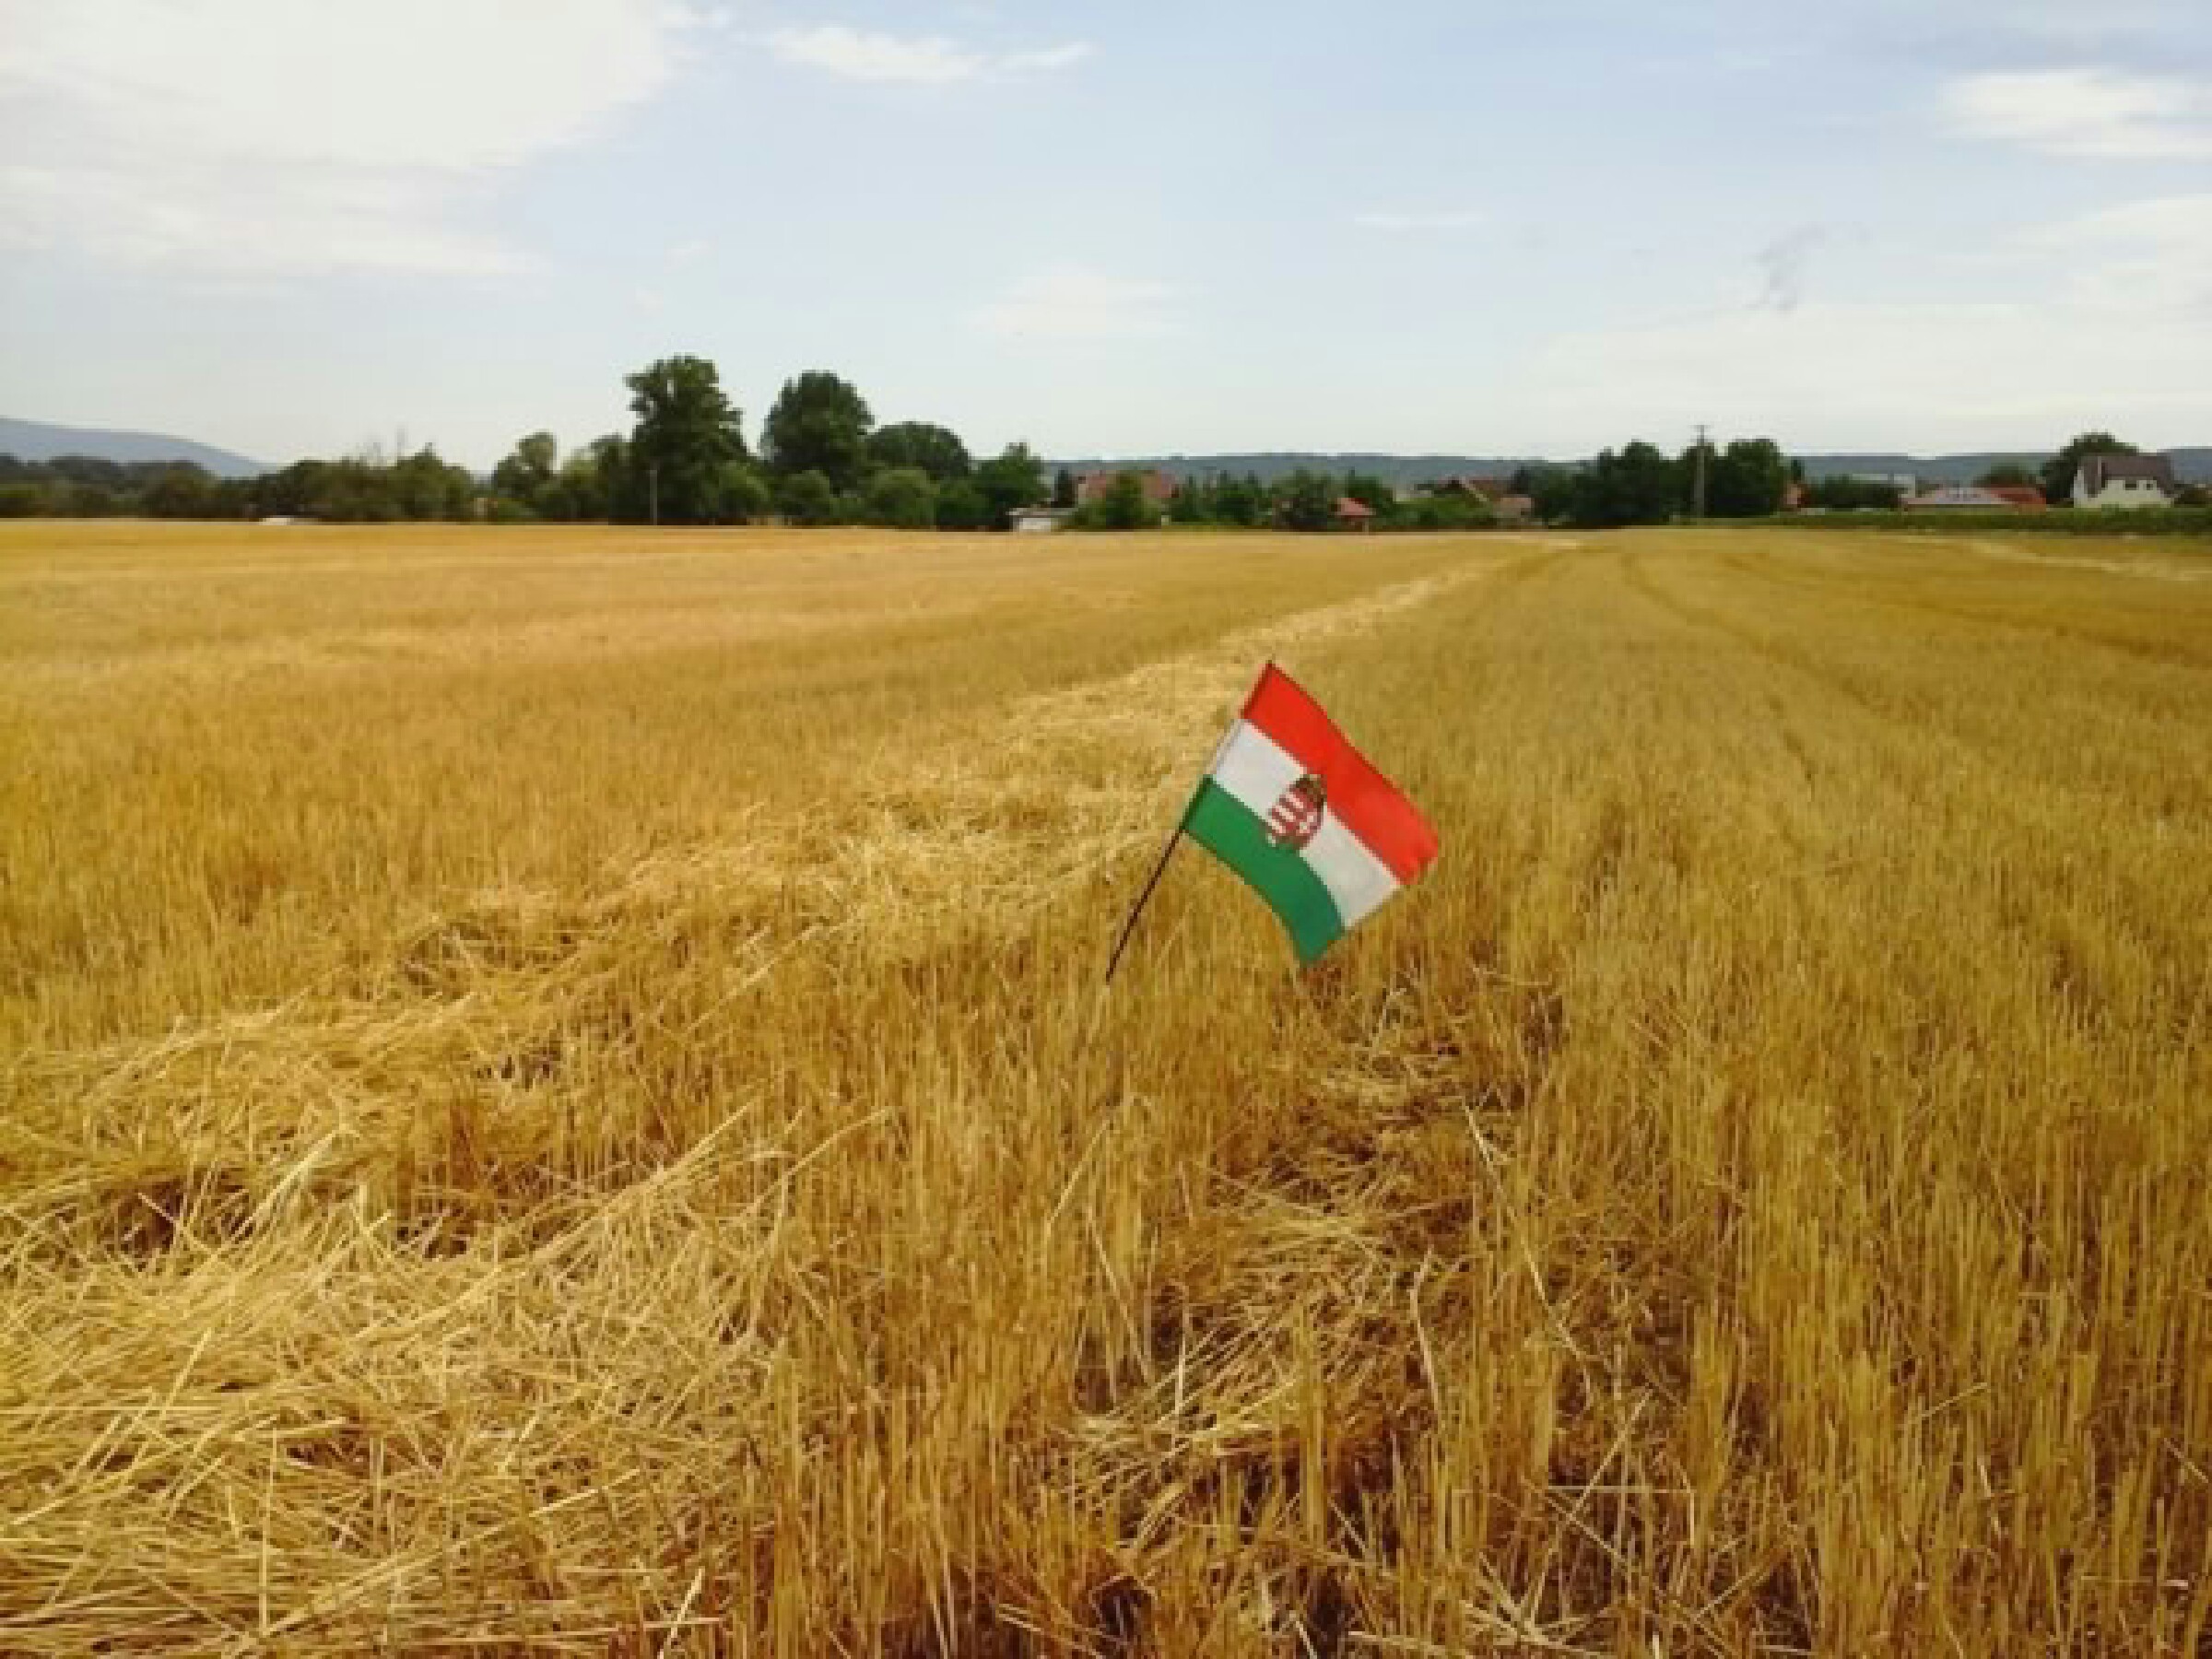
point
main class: Cropland
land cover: Common wheat
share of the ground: > 75 %
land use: Agriculture (excluding fallow land and kitchen gardens)
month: July
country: HU
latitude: 47.7133
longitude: 19.1767
